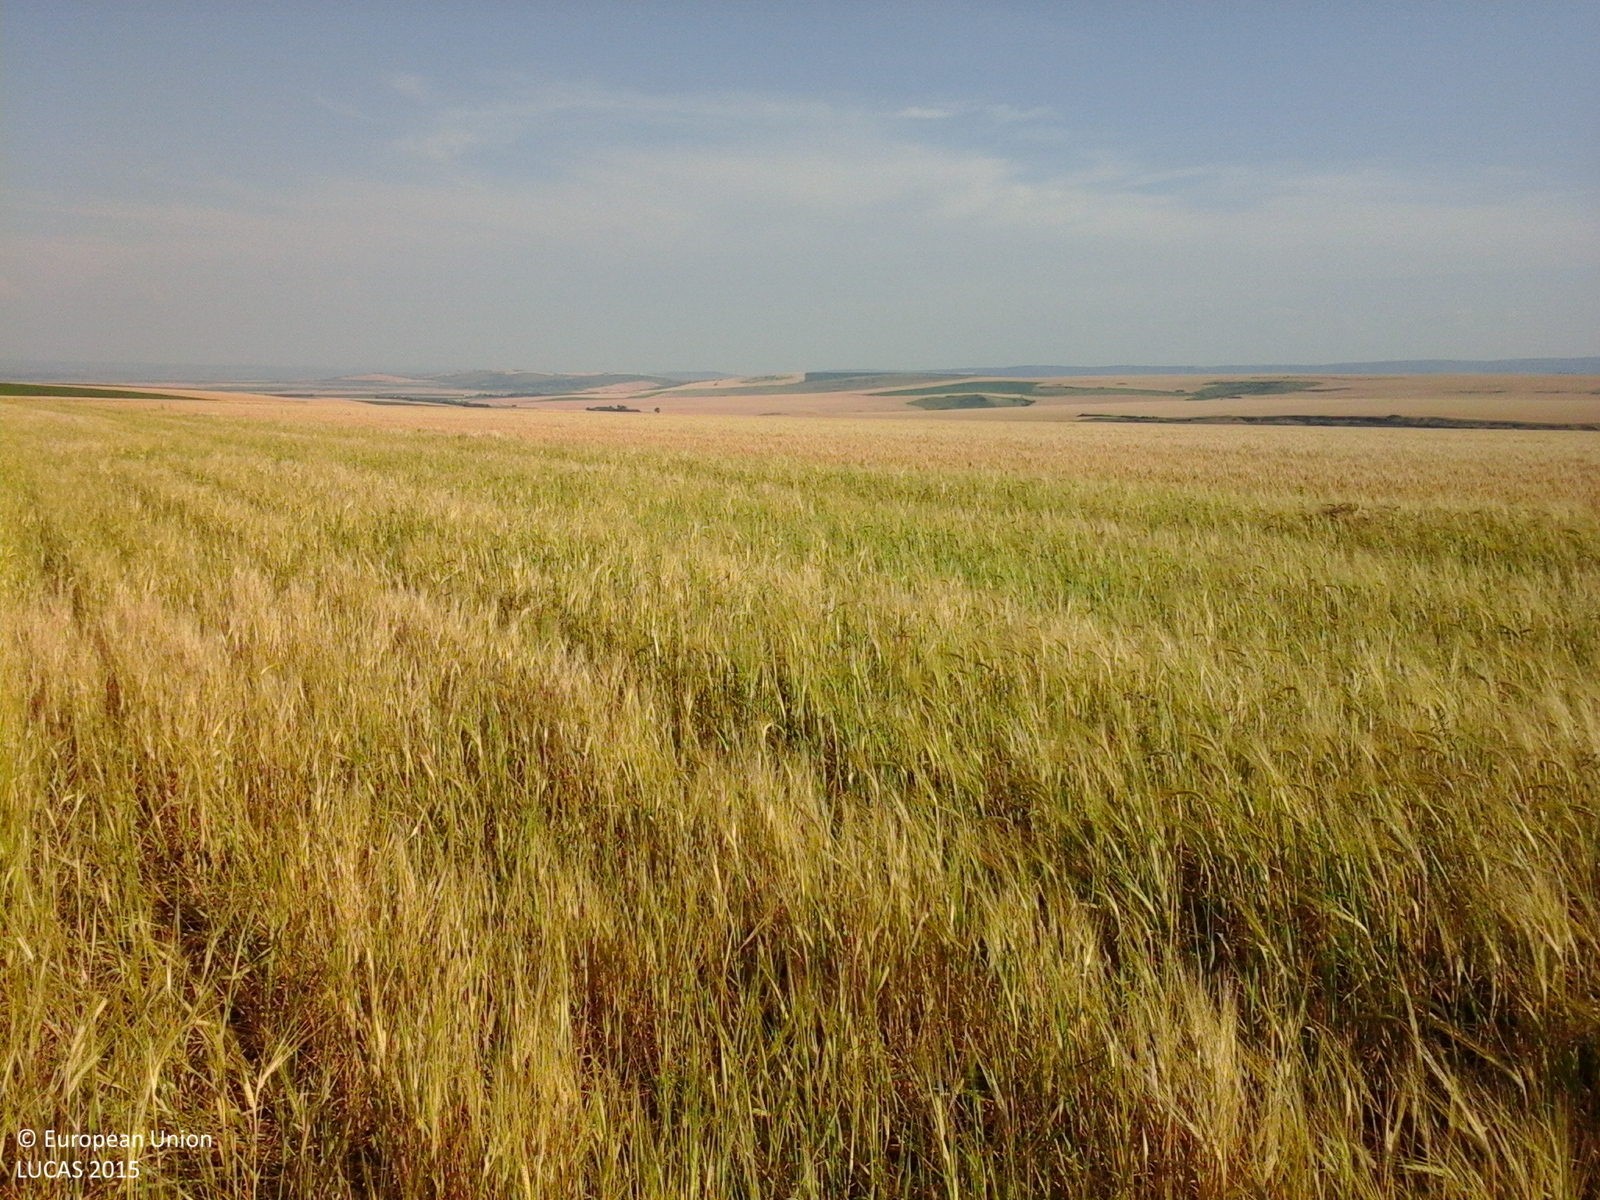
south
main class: Cropland
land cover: Barley
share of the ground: > 75 %
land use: Agriculture (excluding fallow land and kitchen gardens)
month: June
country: RO
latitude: 46.8011
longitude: 28.0958
